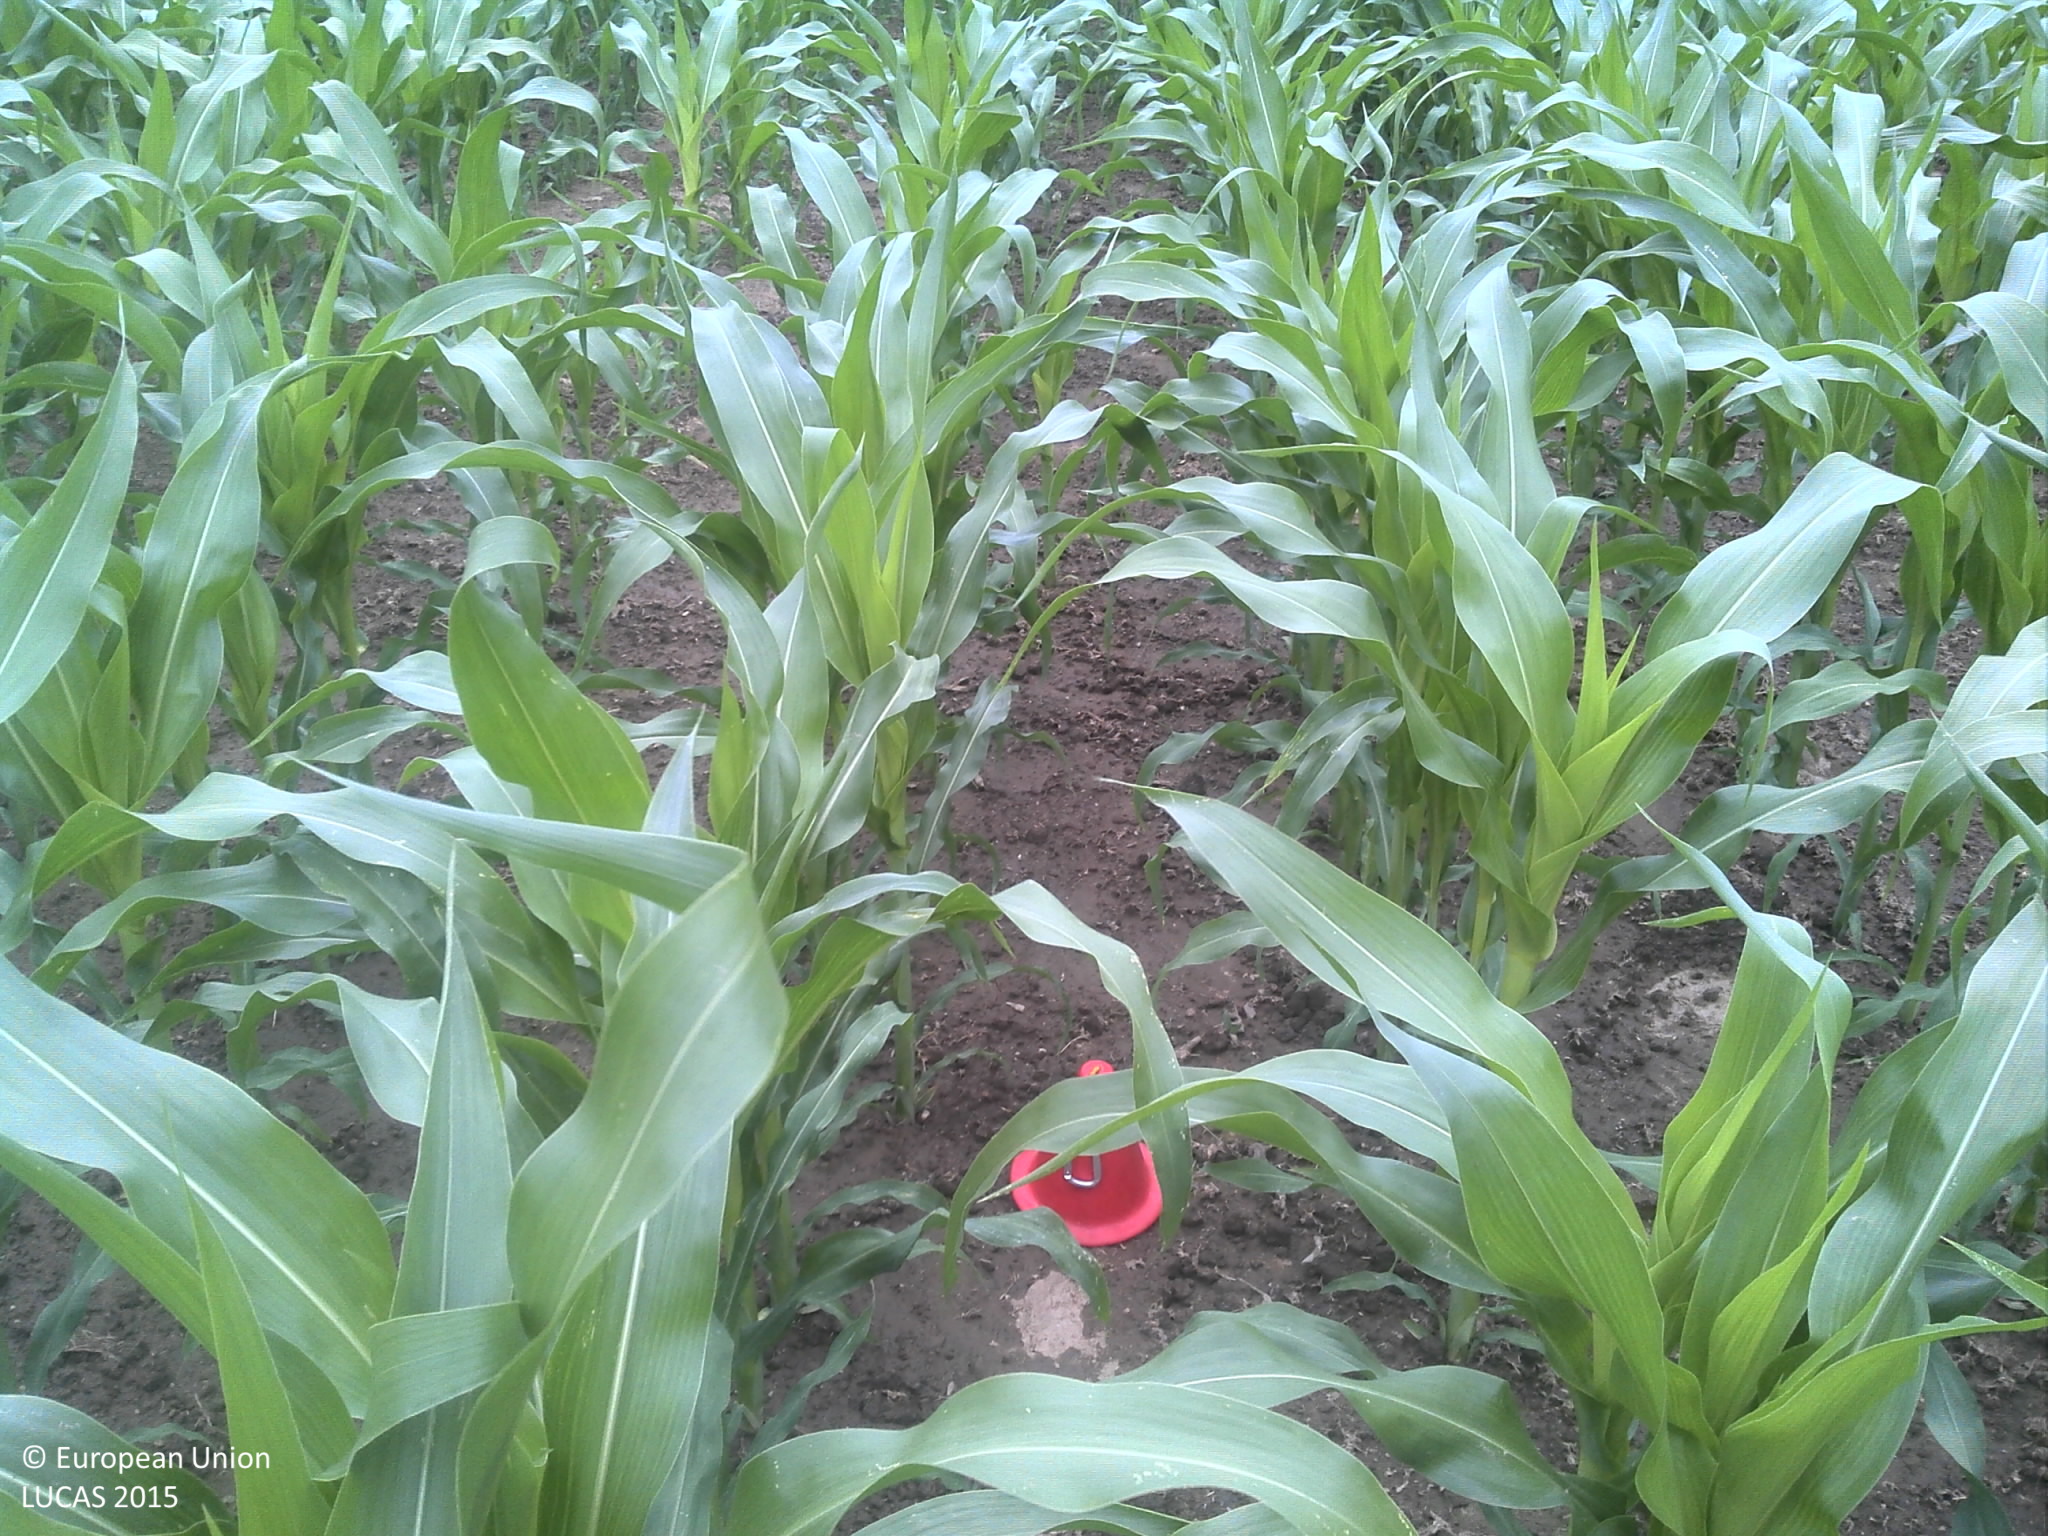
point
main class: Cropland
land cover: Maize
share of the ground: > 75 %
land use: Agriculture (excluding fallow land and kitchen gardens)
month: June
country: PT
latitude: 41.2958
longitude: -8.2363
